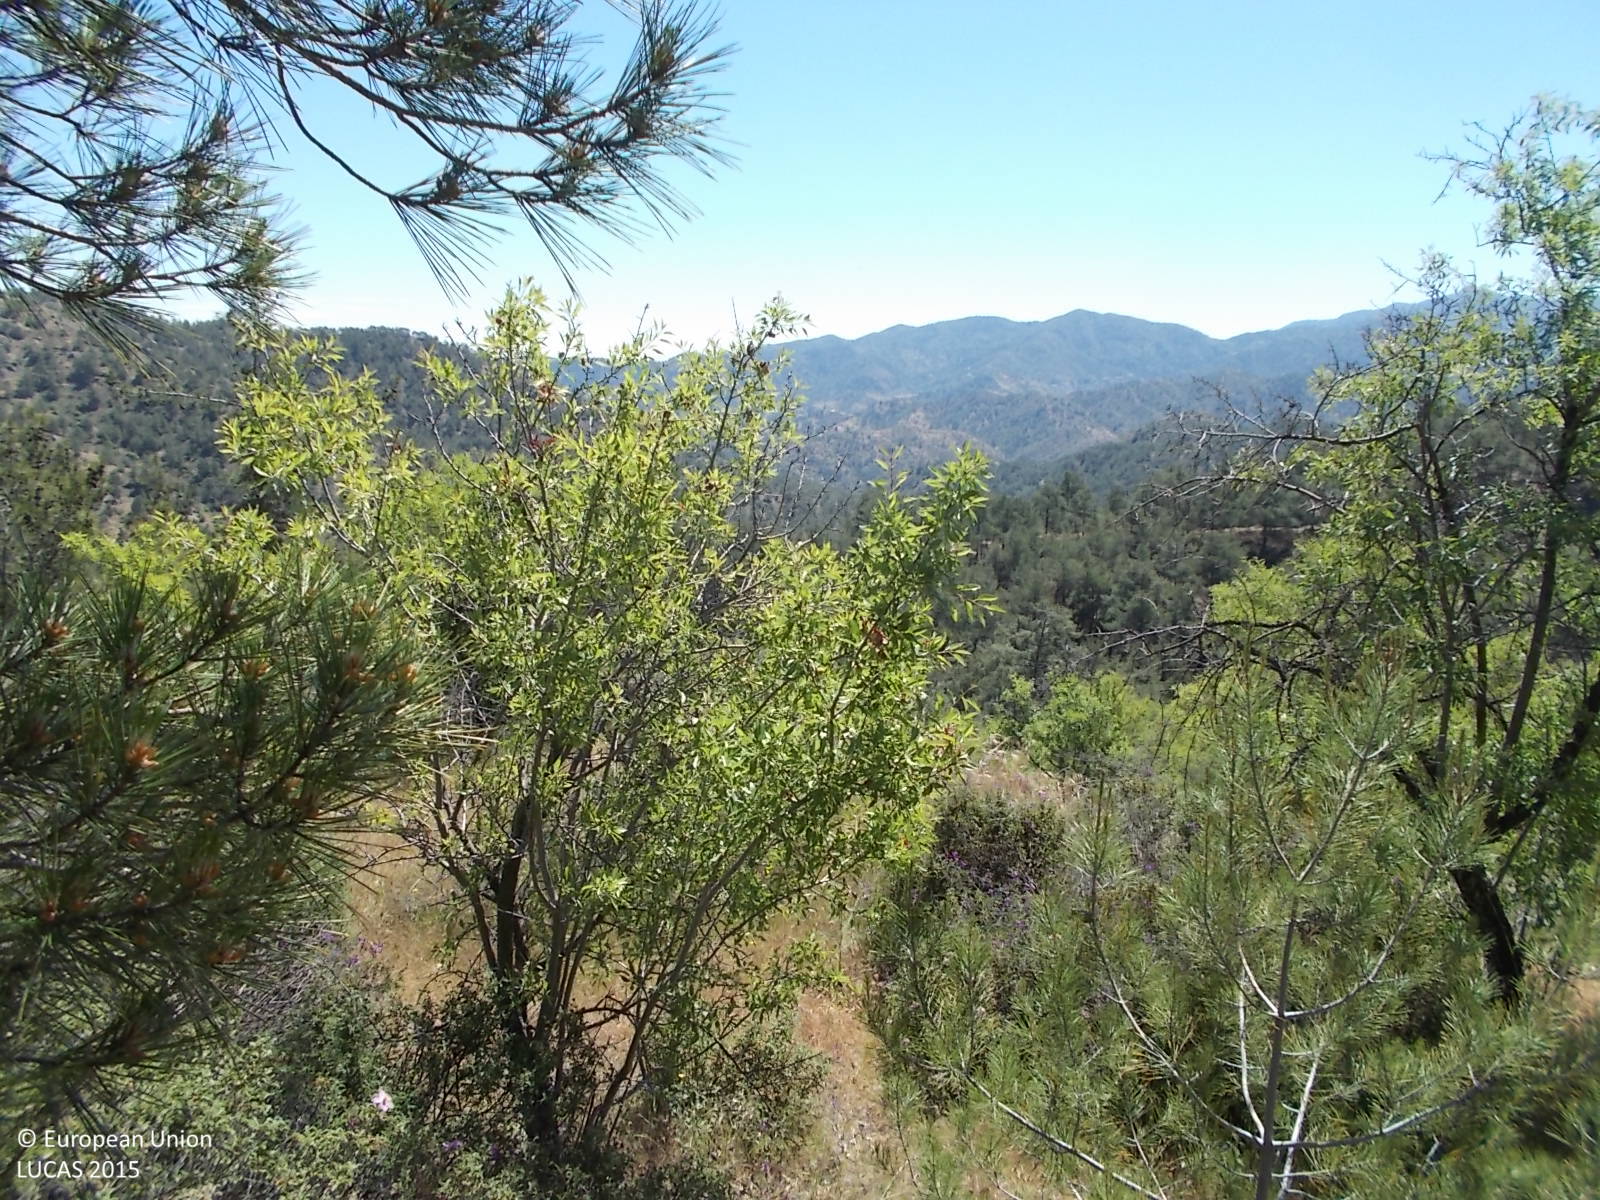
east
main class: Woodland
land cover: Pine dominated coniferous woodland
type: coniferous forest of the mediterranean region
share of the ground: > 75 %
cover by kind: coniferous forest trees 100 %
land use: Semi-natural and natural areas not in use
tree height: > 5 m
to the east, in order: Pine dominated coniferous woodland; Nuts trees; Grassland with sparse tree/shrub cover; Shrubland with sparse tree cover; Tracks; Shrubland with sparse tree cover; Pine dominated coniferous woodland; Shrubland with sparse tree cover; Rivers and streams; Pine dominated coniferous woodland; Shrubland with sparse tree cover
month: May
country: CY
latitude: 34.9741
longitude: 33.1023
